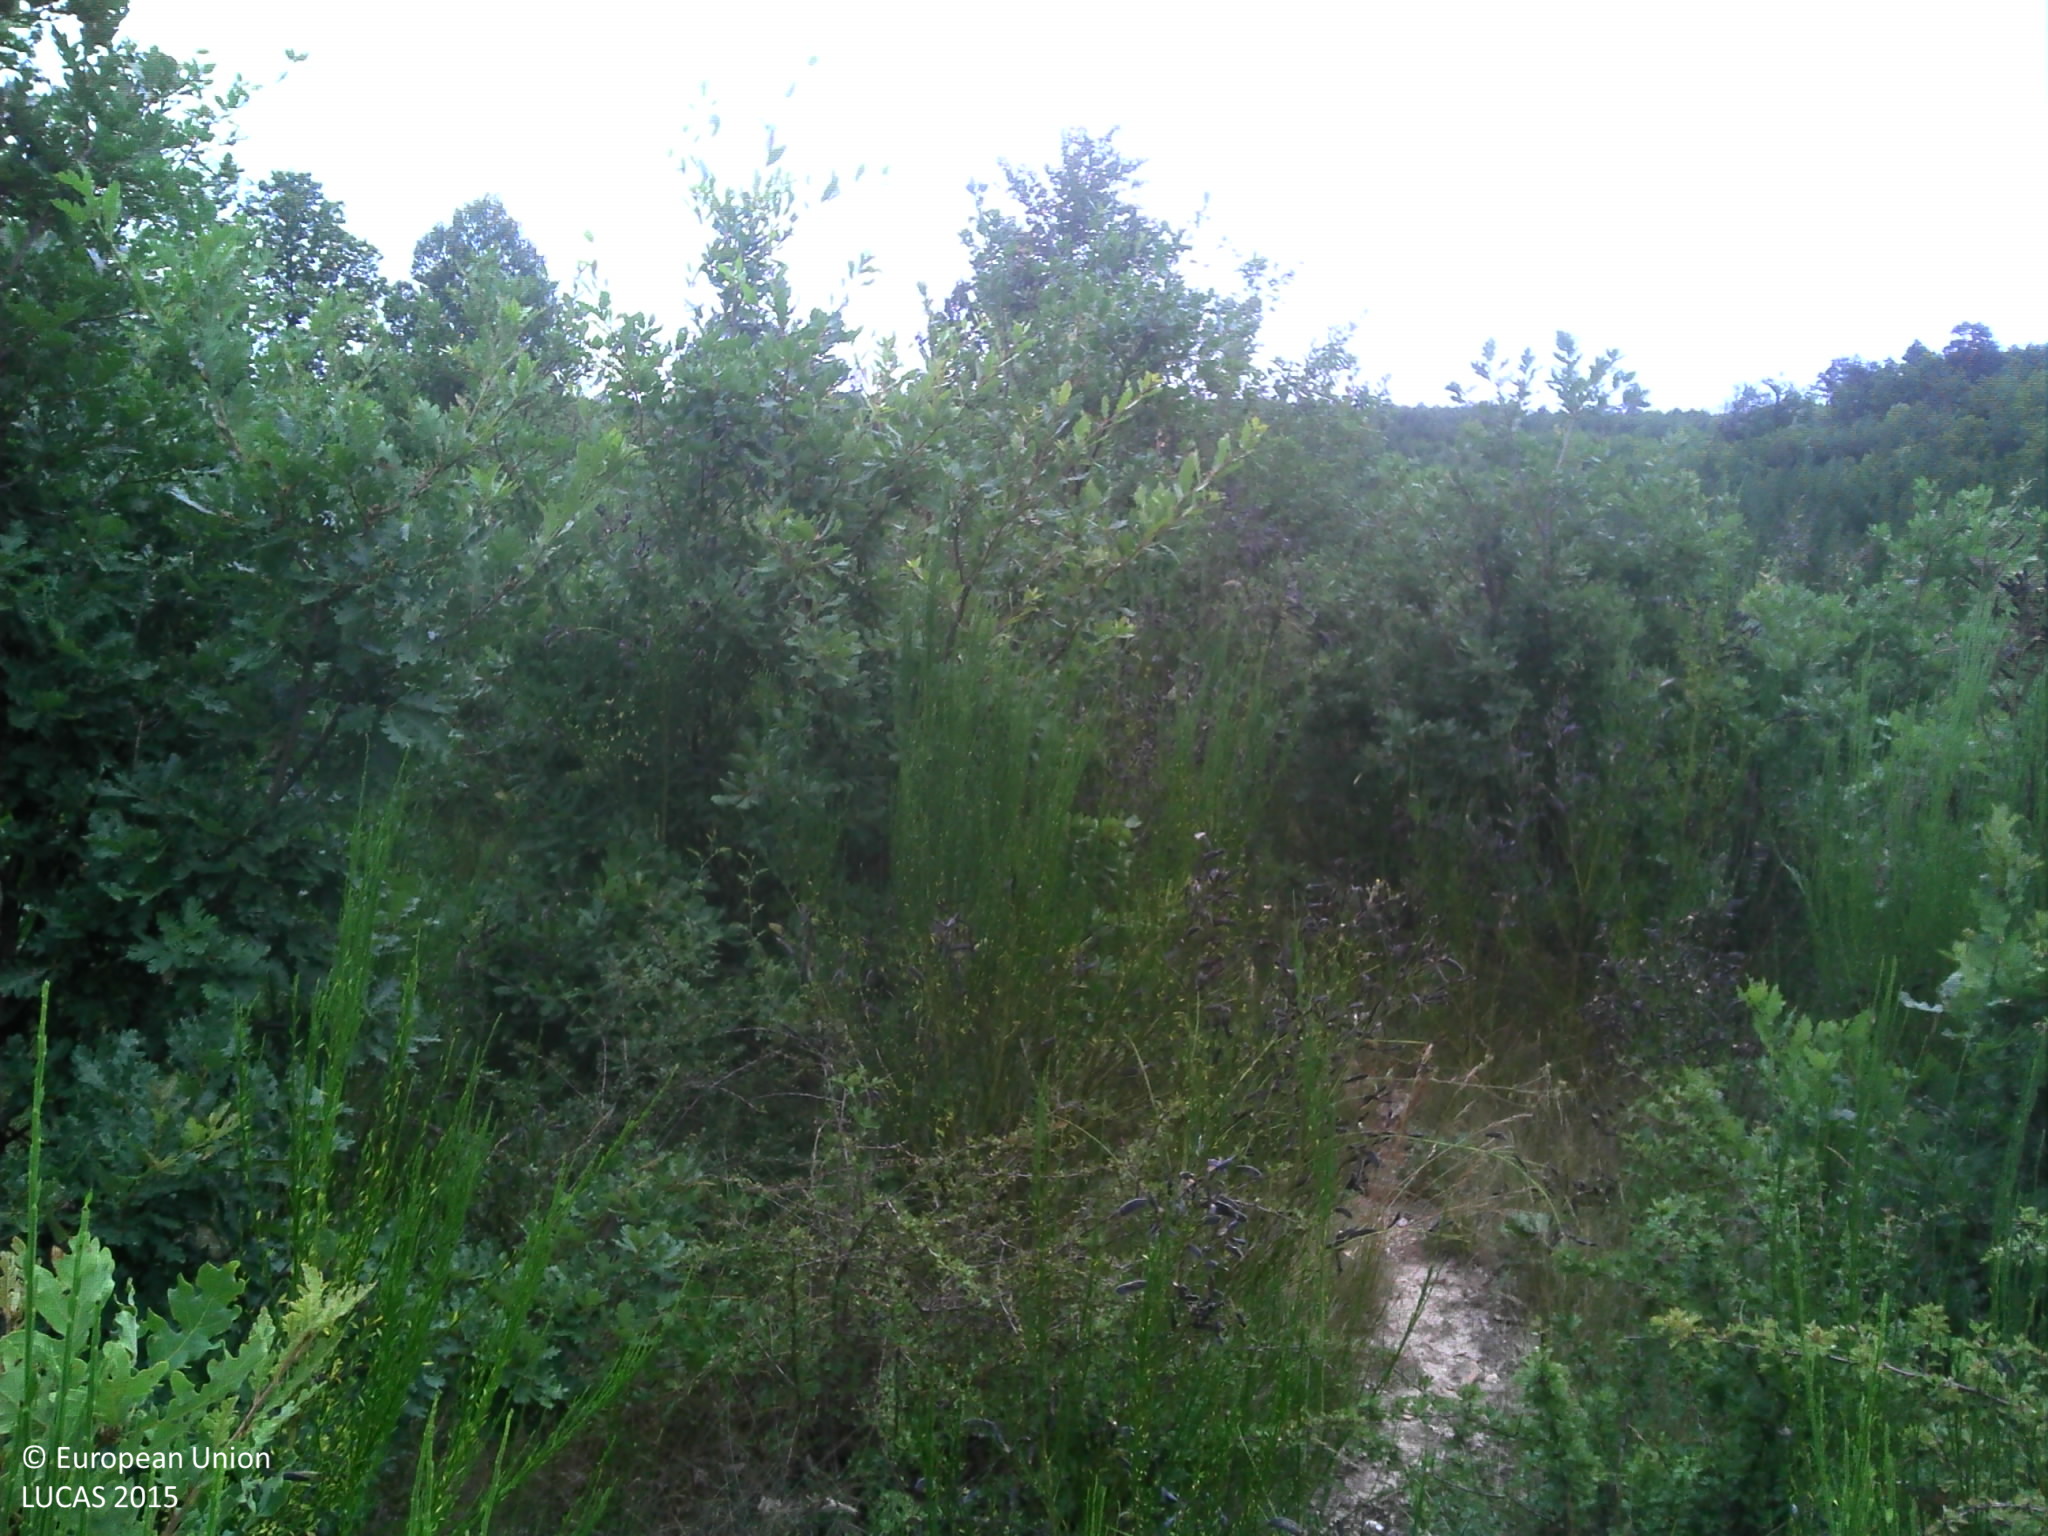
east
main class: Shrubland
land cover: Shrubland with sparse tree cover
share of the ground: > 75 %
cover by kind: shrubs 50 %, herbaceous plants 45 %, broadleaved forest trees 5 %
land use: Agriculture (excluding fallow land and kitchen gardens)
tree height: < 5 m
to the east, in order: Shrubland with sparse tree cover; Broadleaved woodland; Shrubland with sparse tree cover; Tracks; Shrubland with sparse tree cover; Broadleaved woodland; Shrubland with sparse tree cover; Grassland without tree/shrub cover
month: July
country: FR
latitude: 44.0936
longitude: 5.5739
